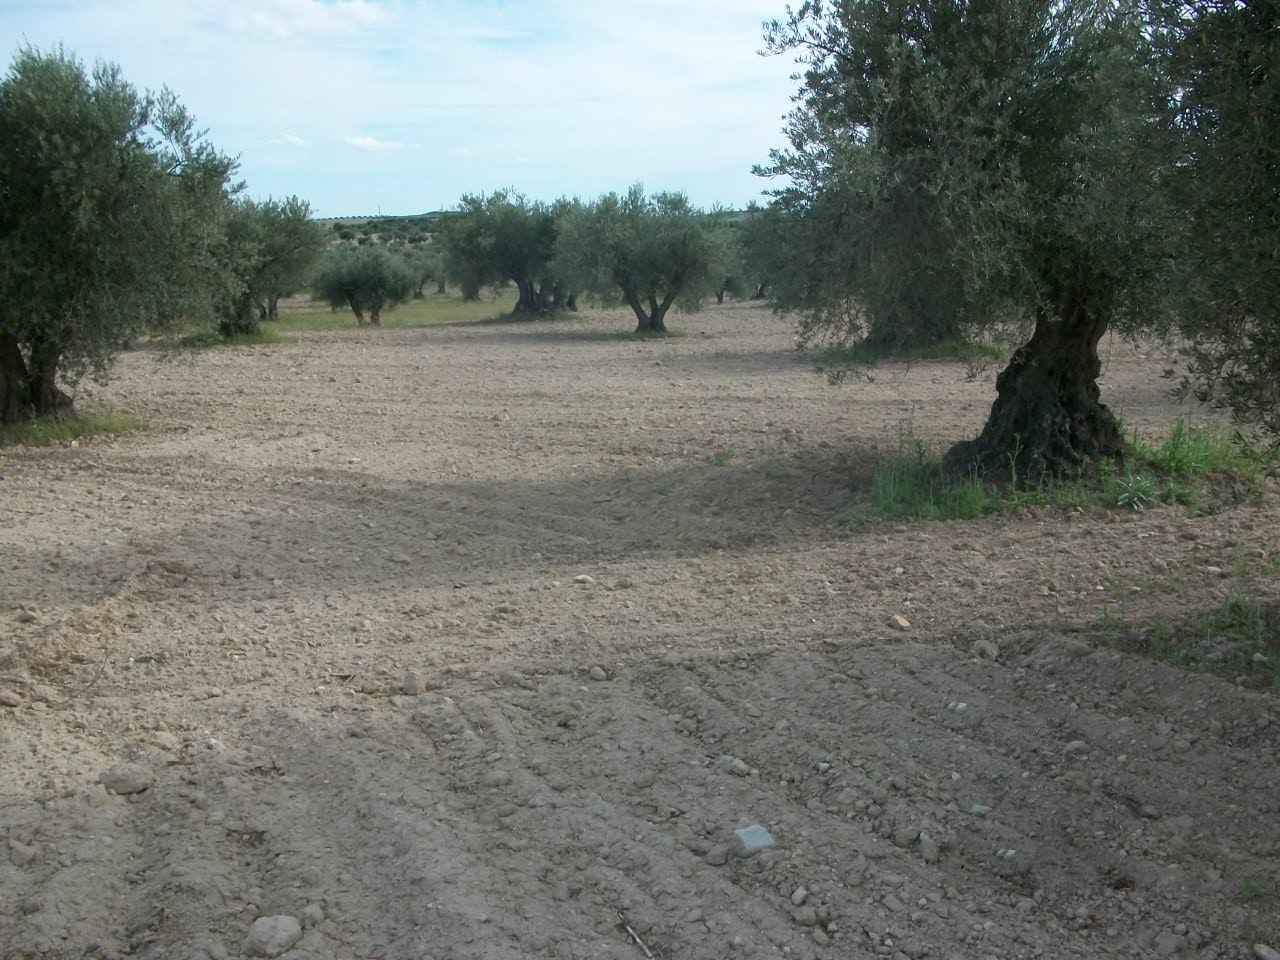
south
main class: Cropland
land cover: Olive groves
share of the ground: 25 - 50 %
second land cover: Other bare soil
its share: > 75 %
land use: Agriculture (excluding fallow land and kitchen gardens)
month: May
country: ES
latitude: 40.0619
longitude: -3.7623
